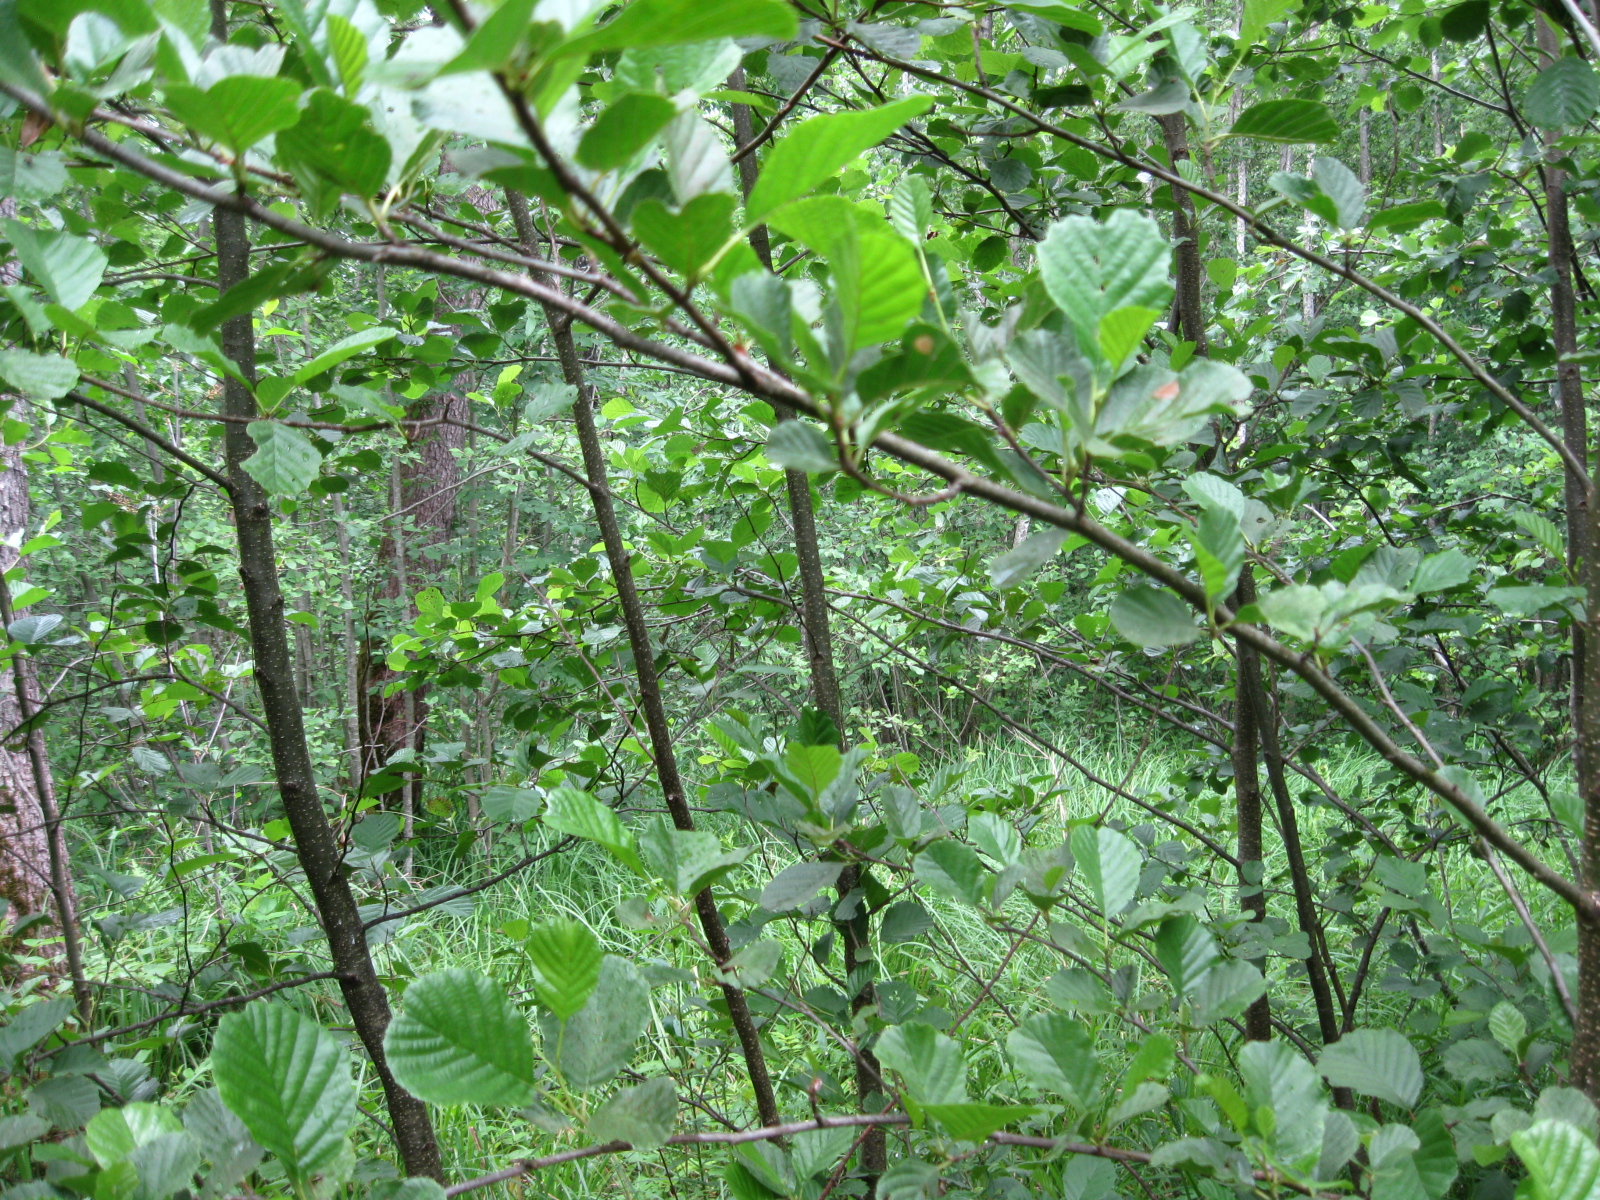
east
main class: Woodland
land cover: Broadleaved woodland
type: non-riverine alder, birch or aspen forest
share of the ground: > 75 %
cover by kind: broadleaved forest trees 80 %, herbaceous plants 15 %, shrubs 5 %
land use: Forestry
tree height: < 5 m
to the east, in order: Broadleaved woodland; Grassland with sparse tree/shrub cover; Ditches and canals; Broadleaved woodland; Spruce dominated mixed woodland
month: June
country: LT
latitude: 55.1016
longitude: 24.0240
